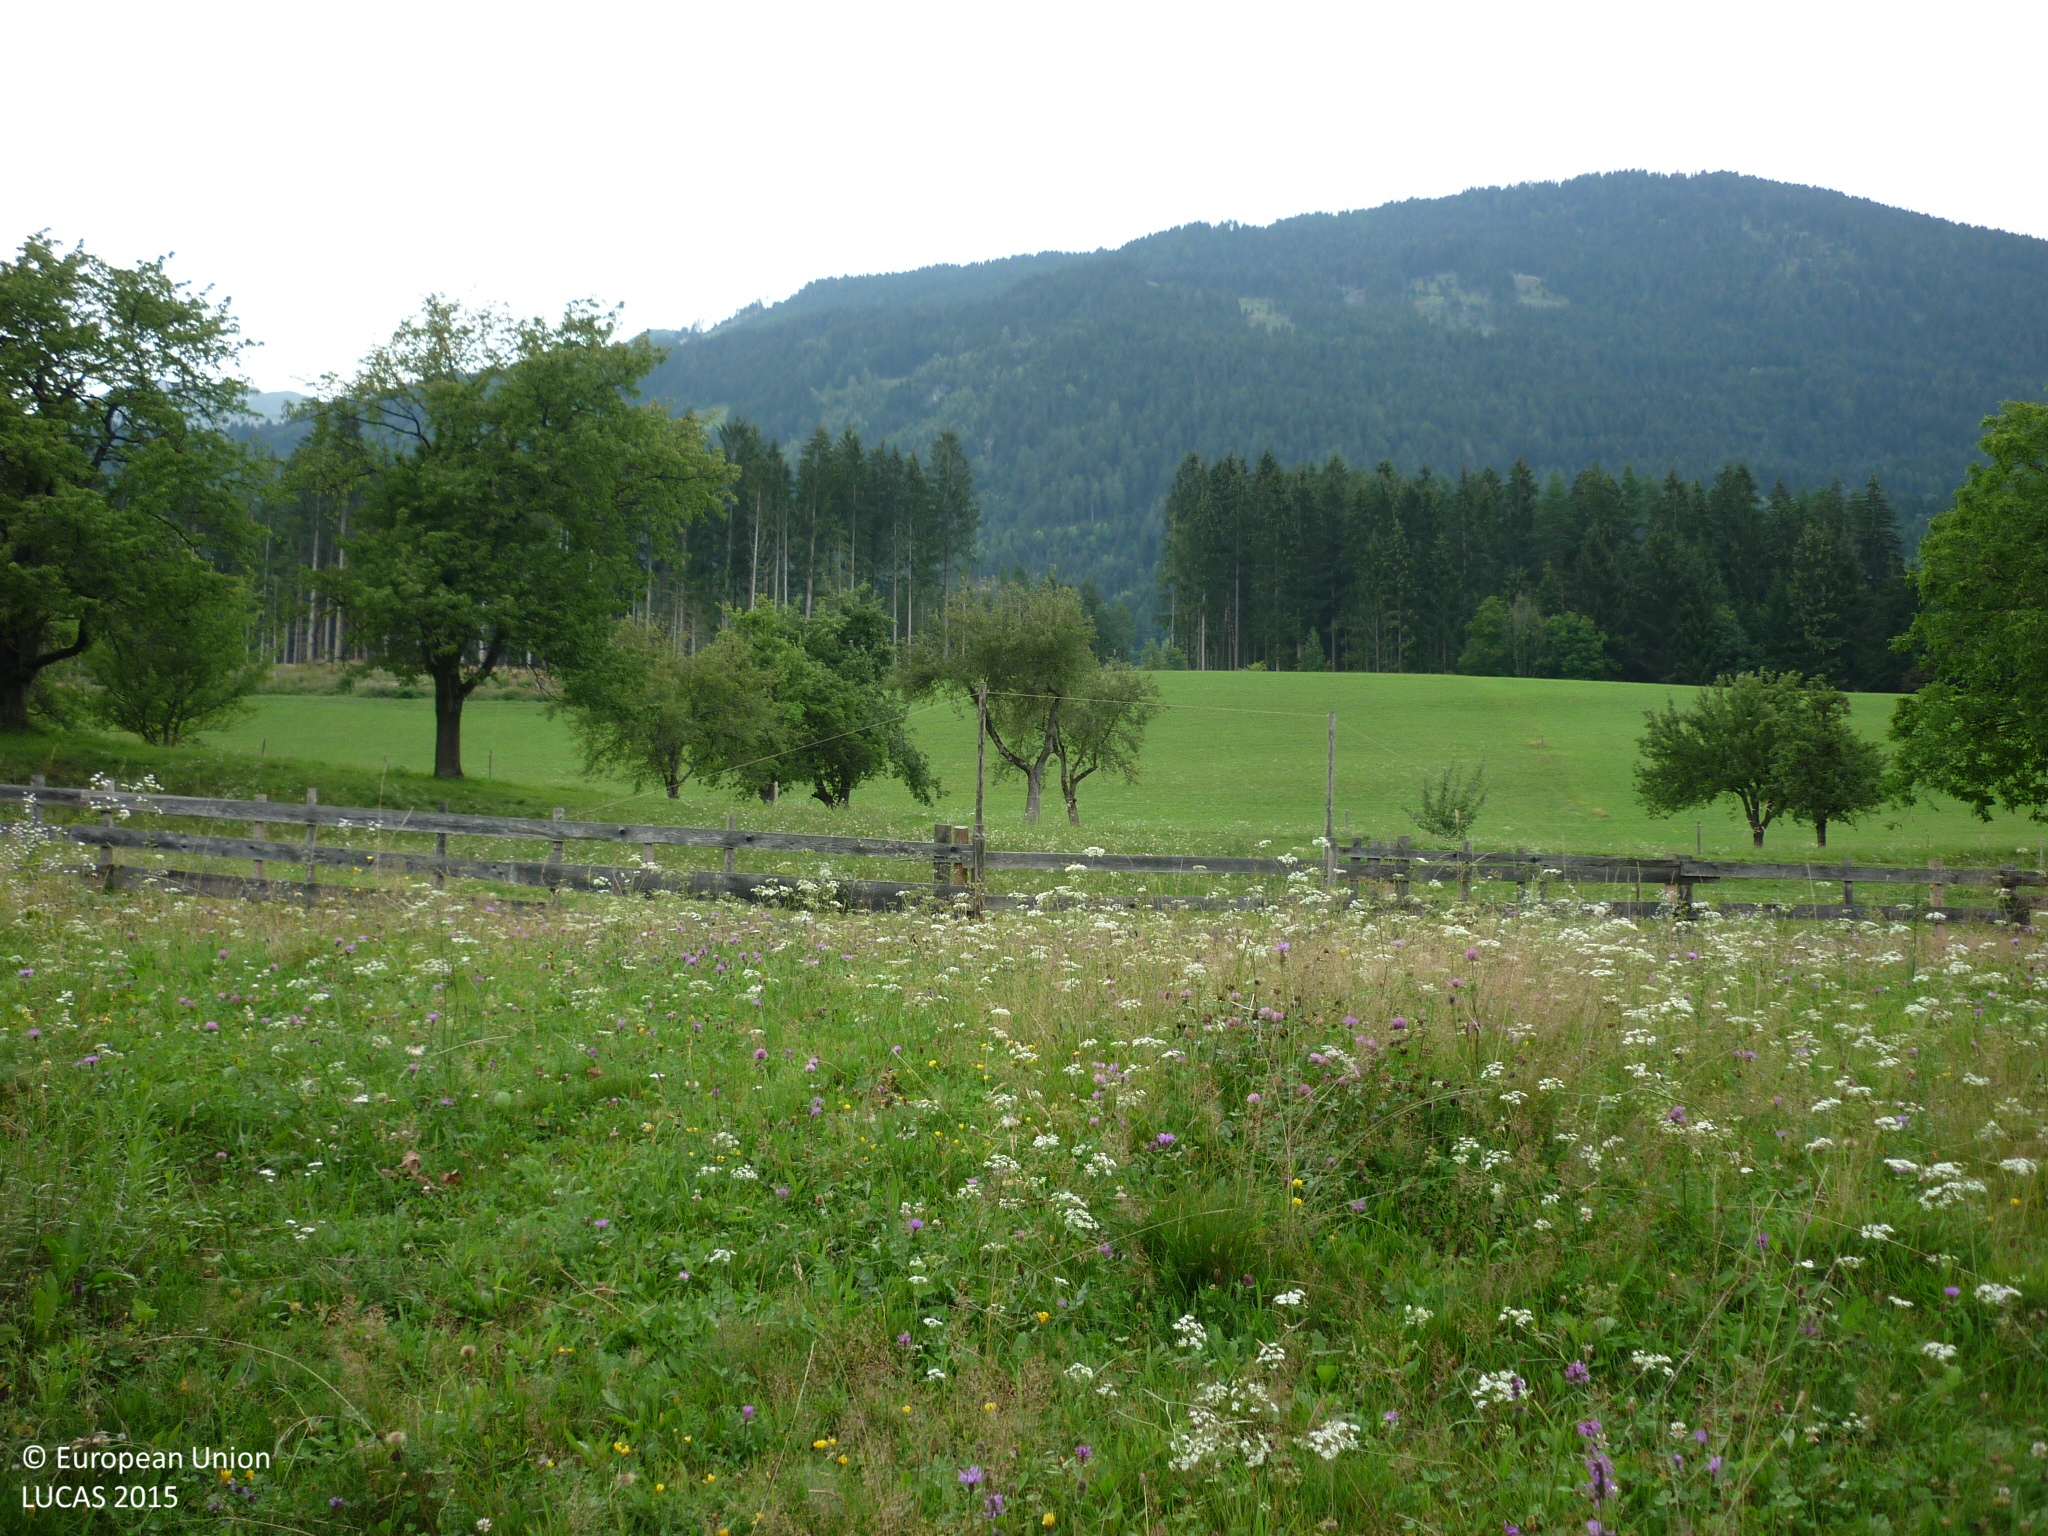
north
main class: Grassland
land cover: Spontaneously vegetated surfaces
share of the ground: > 75 %
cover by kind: herbaceous plants 100 %
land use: Residential
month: August
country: AT
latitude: 46.8373
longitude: 13.4196
